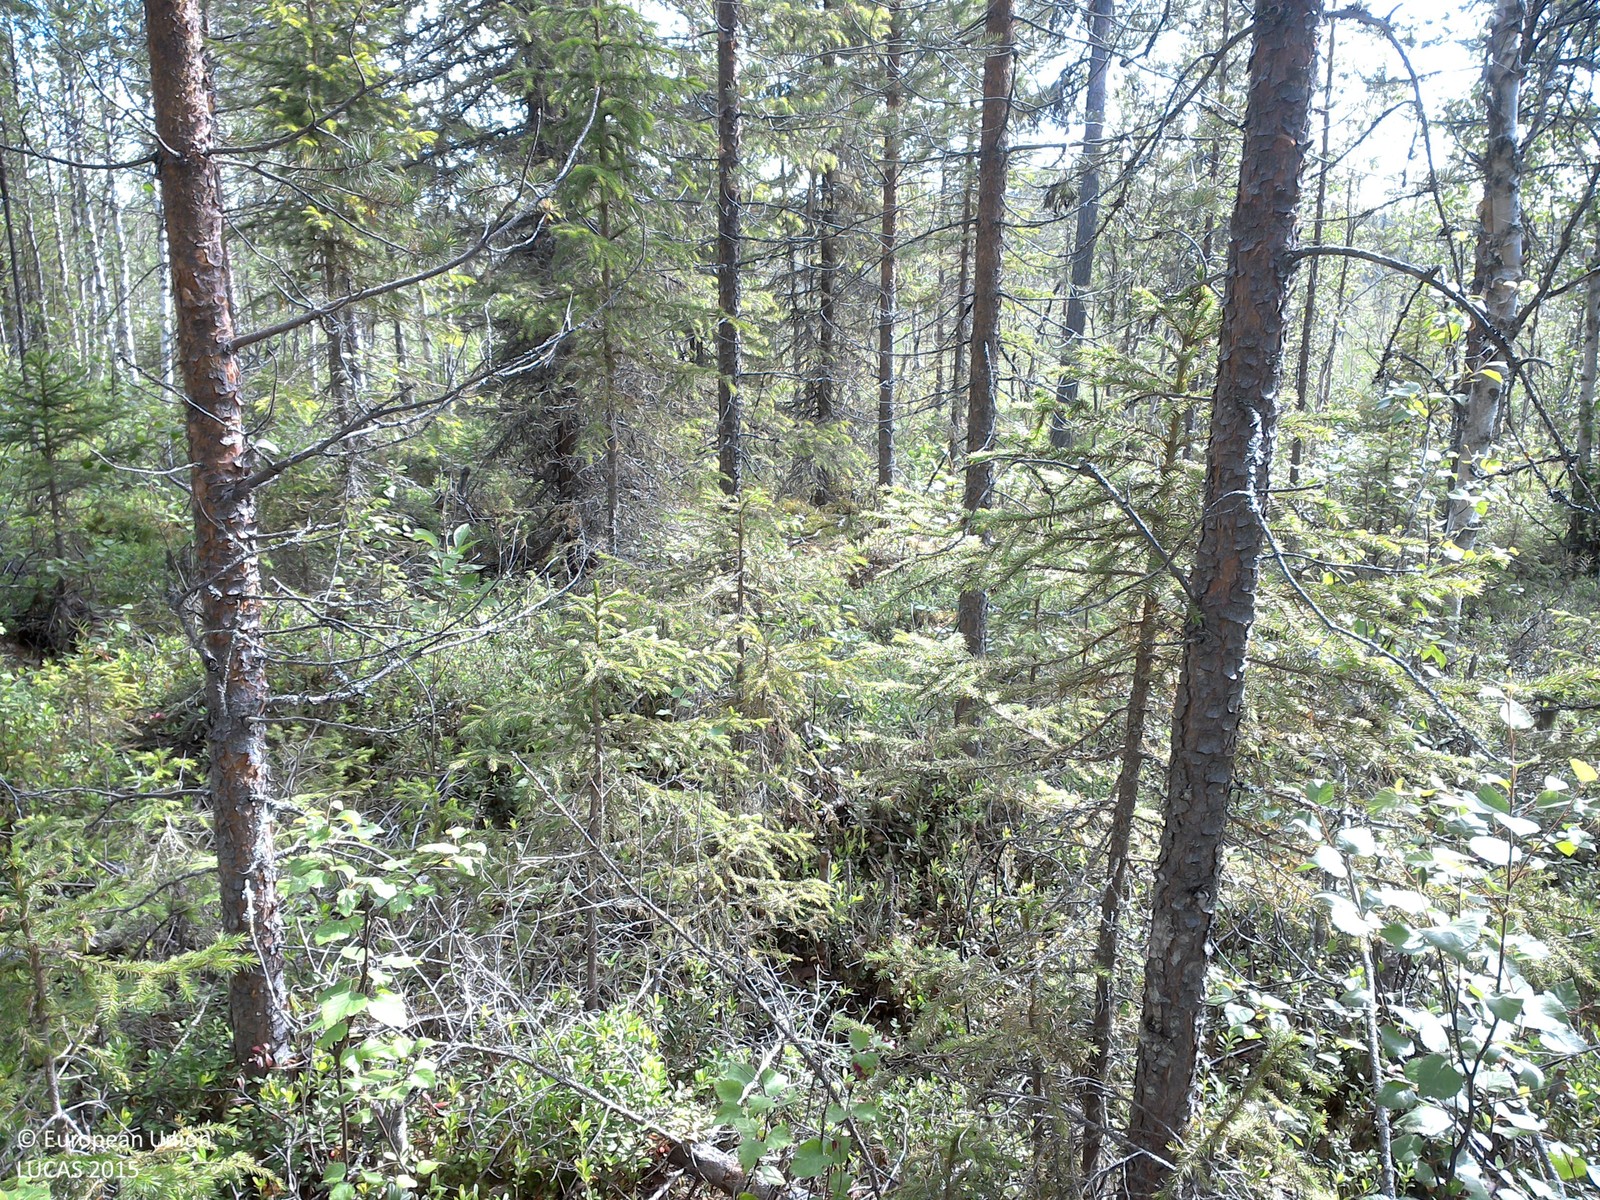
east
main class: Woodland
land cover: Pine dominated mixed woodland
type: boreal forest
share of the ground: 25 - 50 %
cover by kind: shrubs 65 %, coniferous forest trees 25 %, broadleaved forest trees 10 %
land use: Forestry
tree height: > 5 m
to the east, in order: Pine dominated mixed woodland; Peatbogs; Pine dominated mixed woodland; Pine dominated coniferous woodland; Peatbogs; Groves; Ditches and canals; Broadleaved woodland; Pine dominated mixed woodland
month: July
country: SE
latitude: 67.2154
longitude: 23.1352
